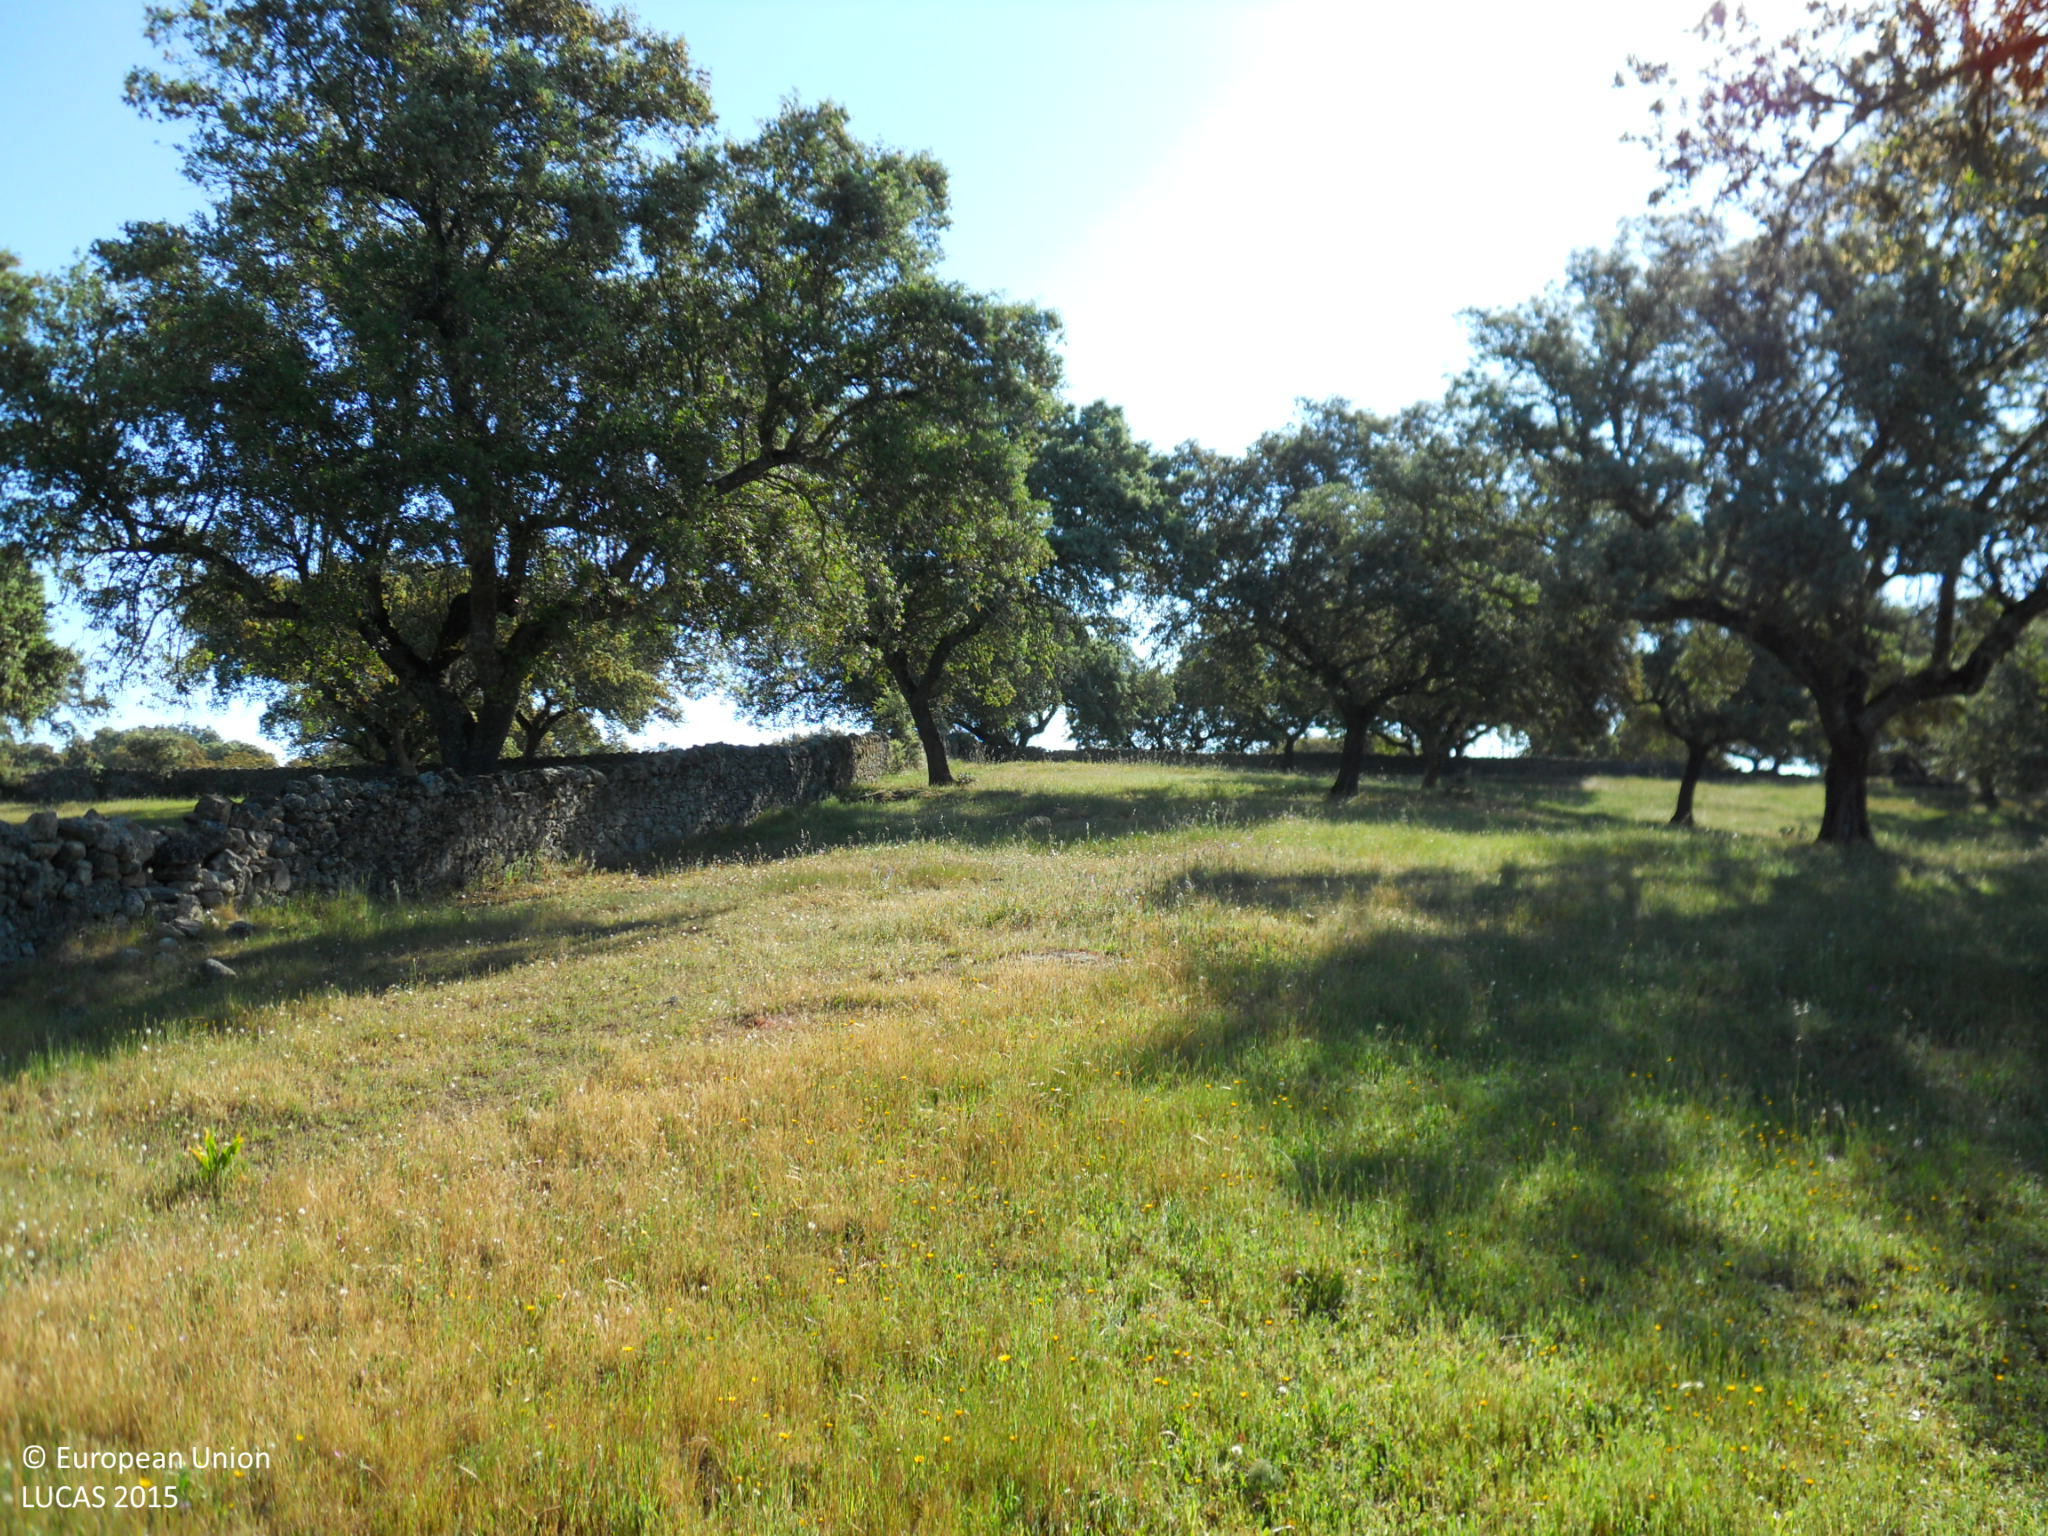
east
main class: Woodland
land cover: Broadleaved woodland
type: broadleaved evergreen forest
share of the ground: 50 - 75 %
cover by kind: broadleaved forest trees 70 %, herbaceous plants 20 %, shrubs 10 %
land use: Forestry
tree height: > 5 m
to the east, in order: Broadleaved woodland; Dry stone walls; Broadleaved woodland; Tracks; Broadleaved woodland
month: April
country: ES
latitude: 39.3106
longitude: -6.9754
